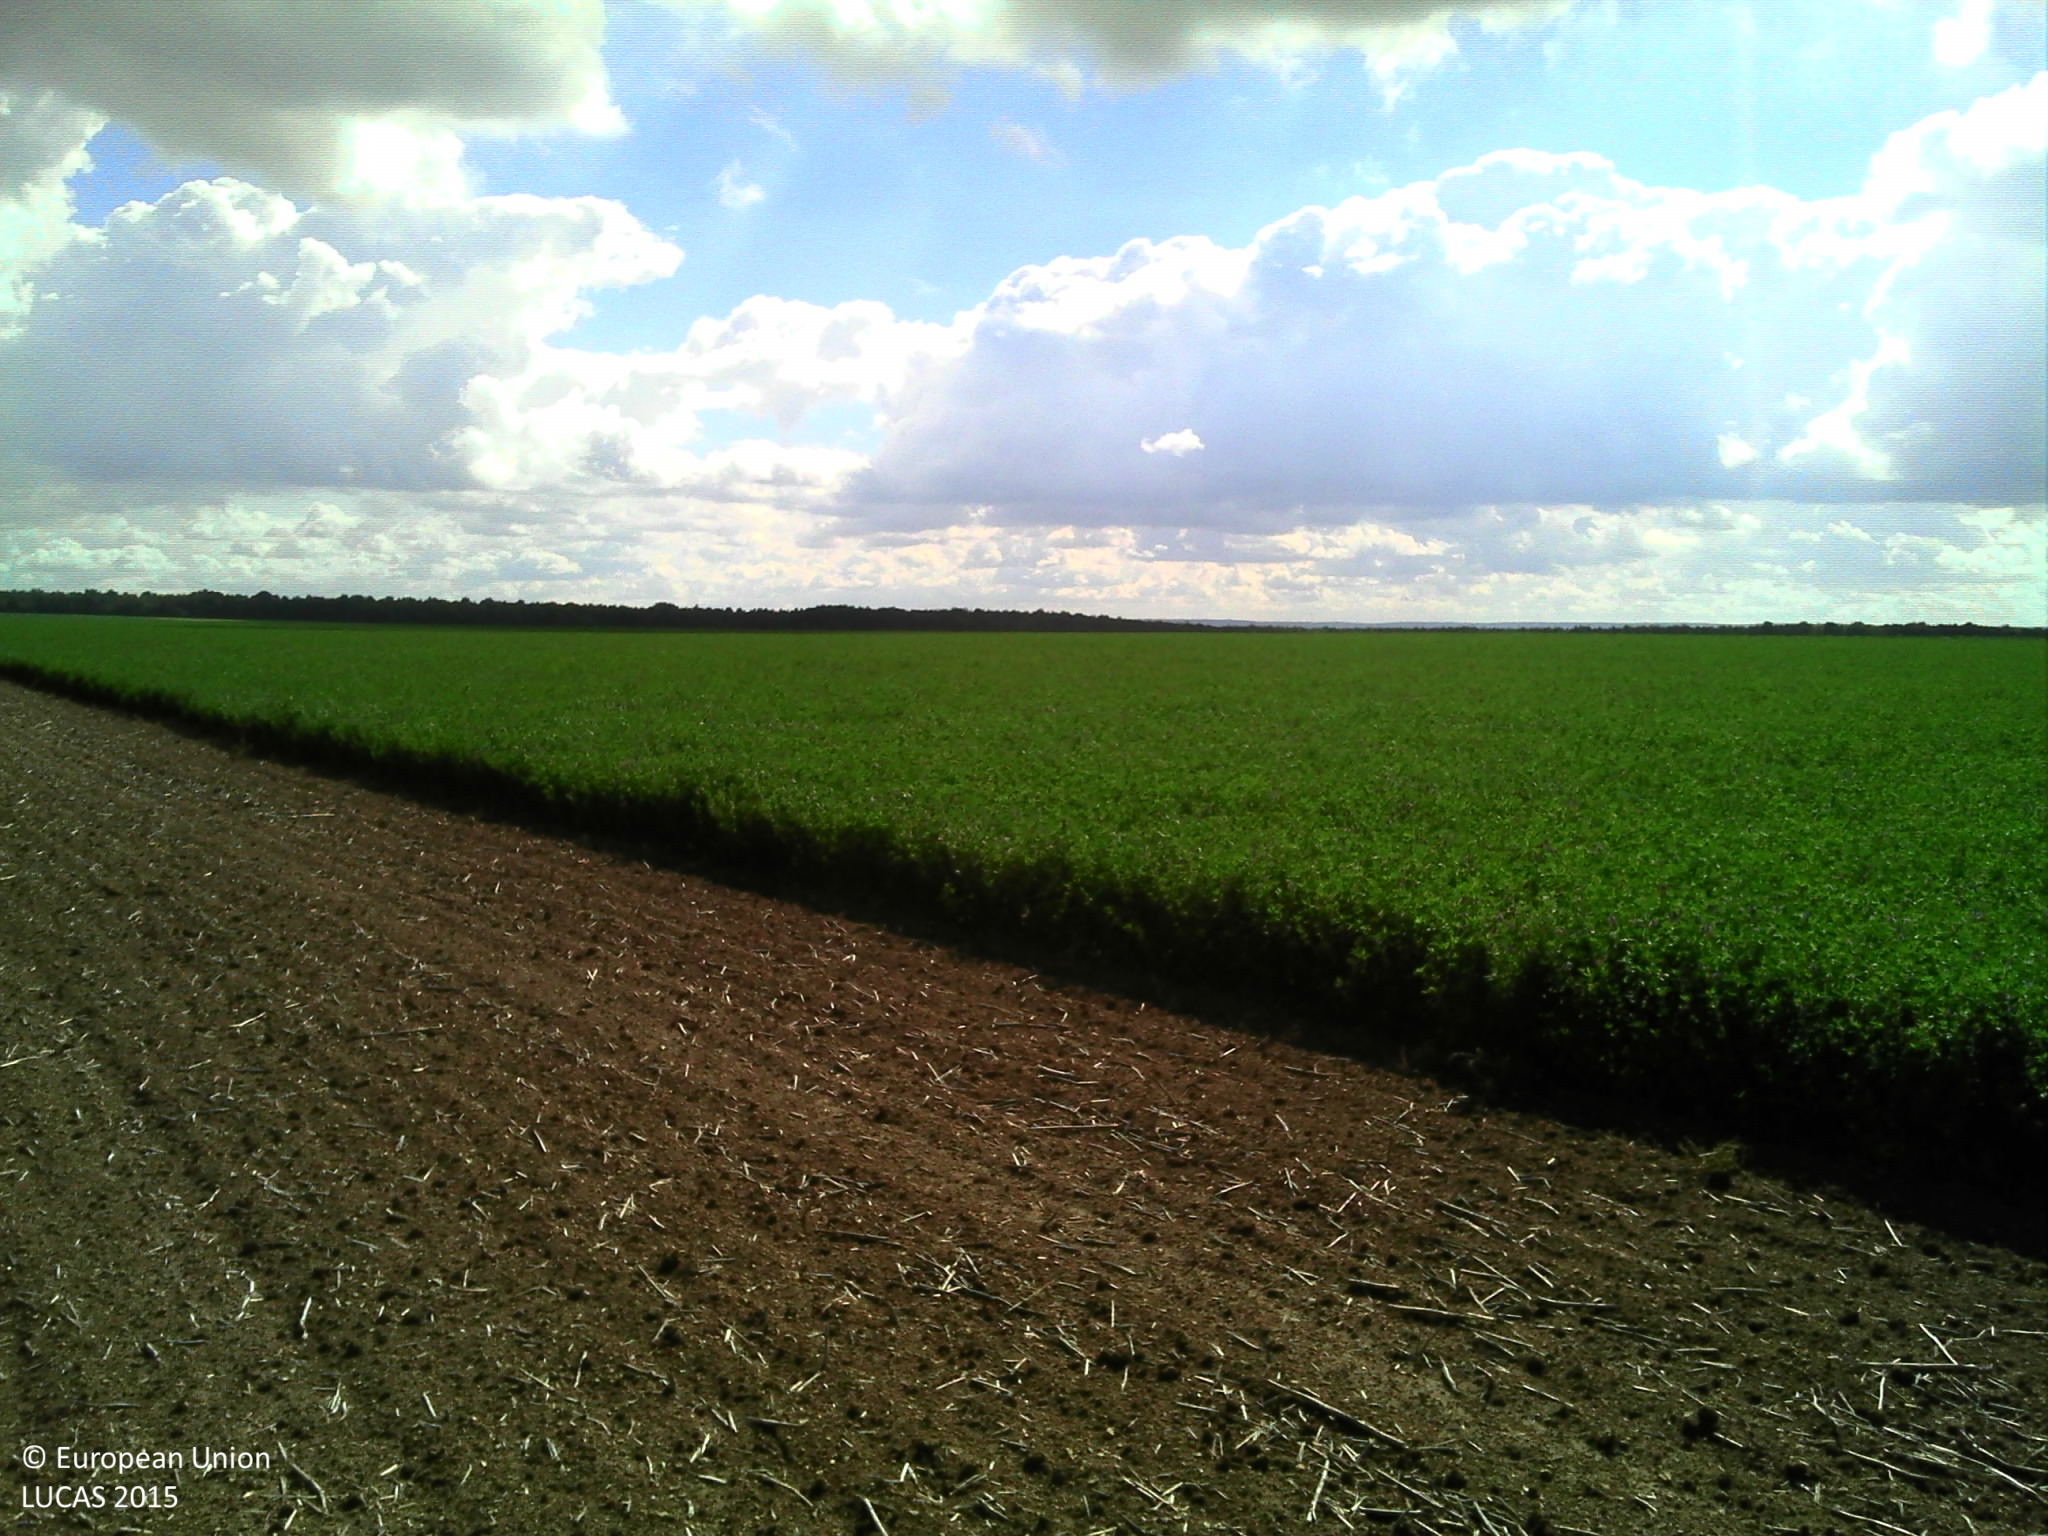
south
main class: Cropland
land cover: Rape and turnip rape
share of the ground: 25 - 50 %
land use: Agriculture (excluding fallow land and kitchen gardens)
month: September
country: FR
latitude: 48.3753
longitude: 3.8256
